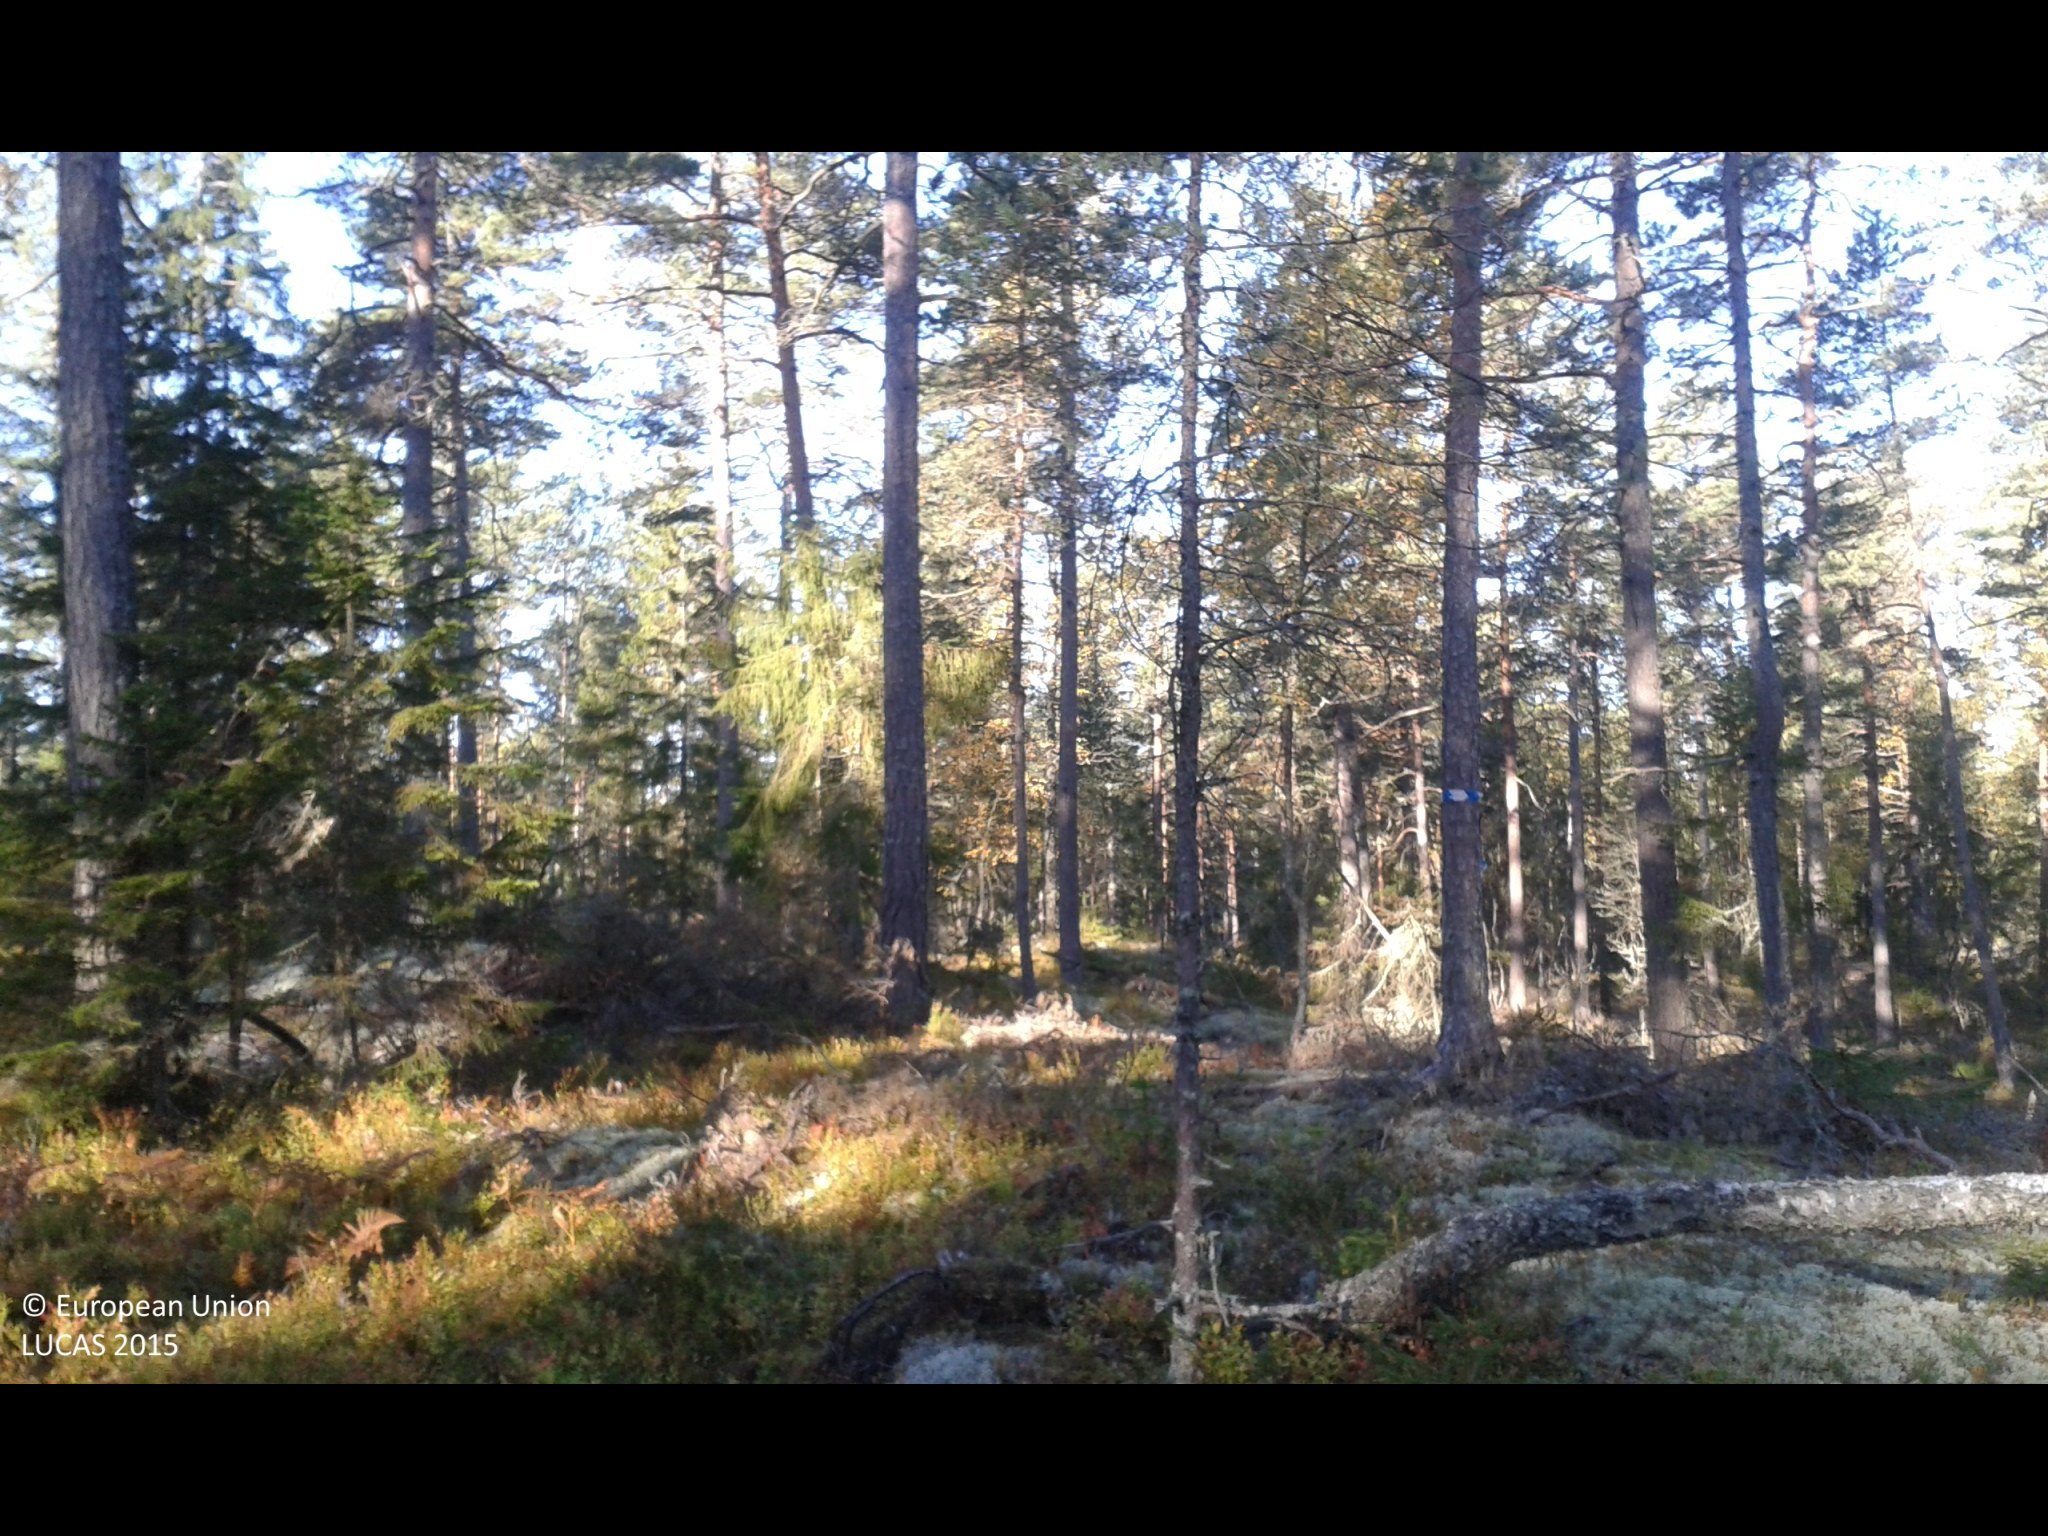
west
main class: Woodland
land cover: Pine dominated coniferous woodland
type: boreal forest
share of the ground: 50 - 75 %
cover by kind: coniferous forest trees 60 %, herbaceous plants 30 %, broadleaved forest trees 10 %
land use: Forestry
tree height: > 5 m
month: October
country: SE
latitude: 59.0240
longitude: 17.4703
